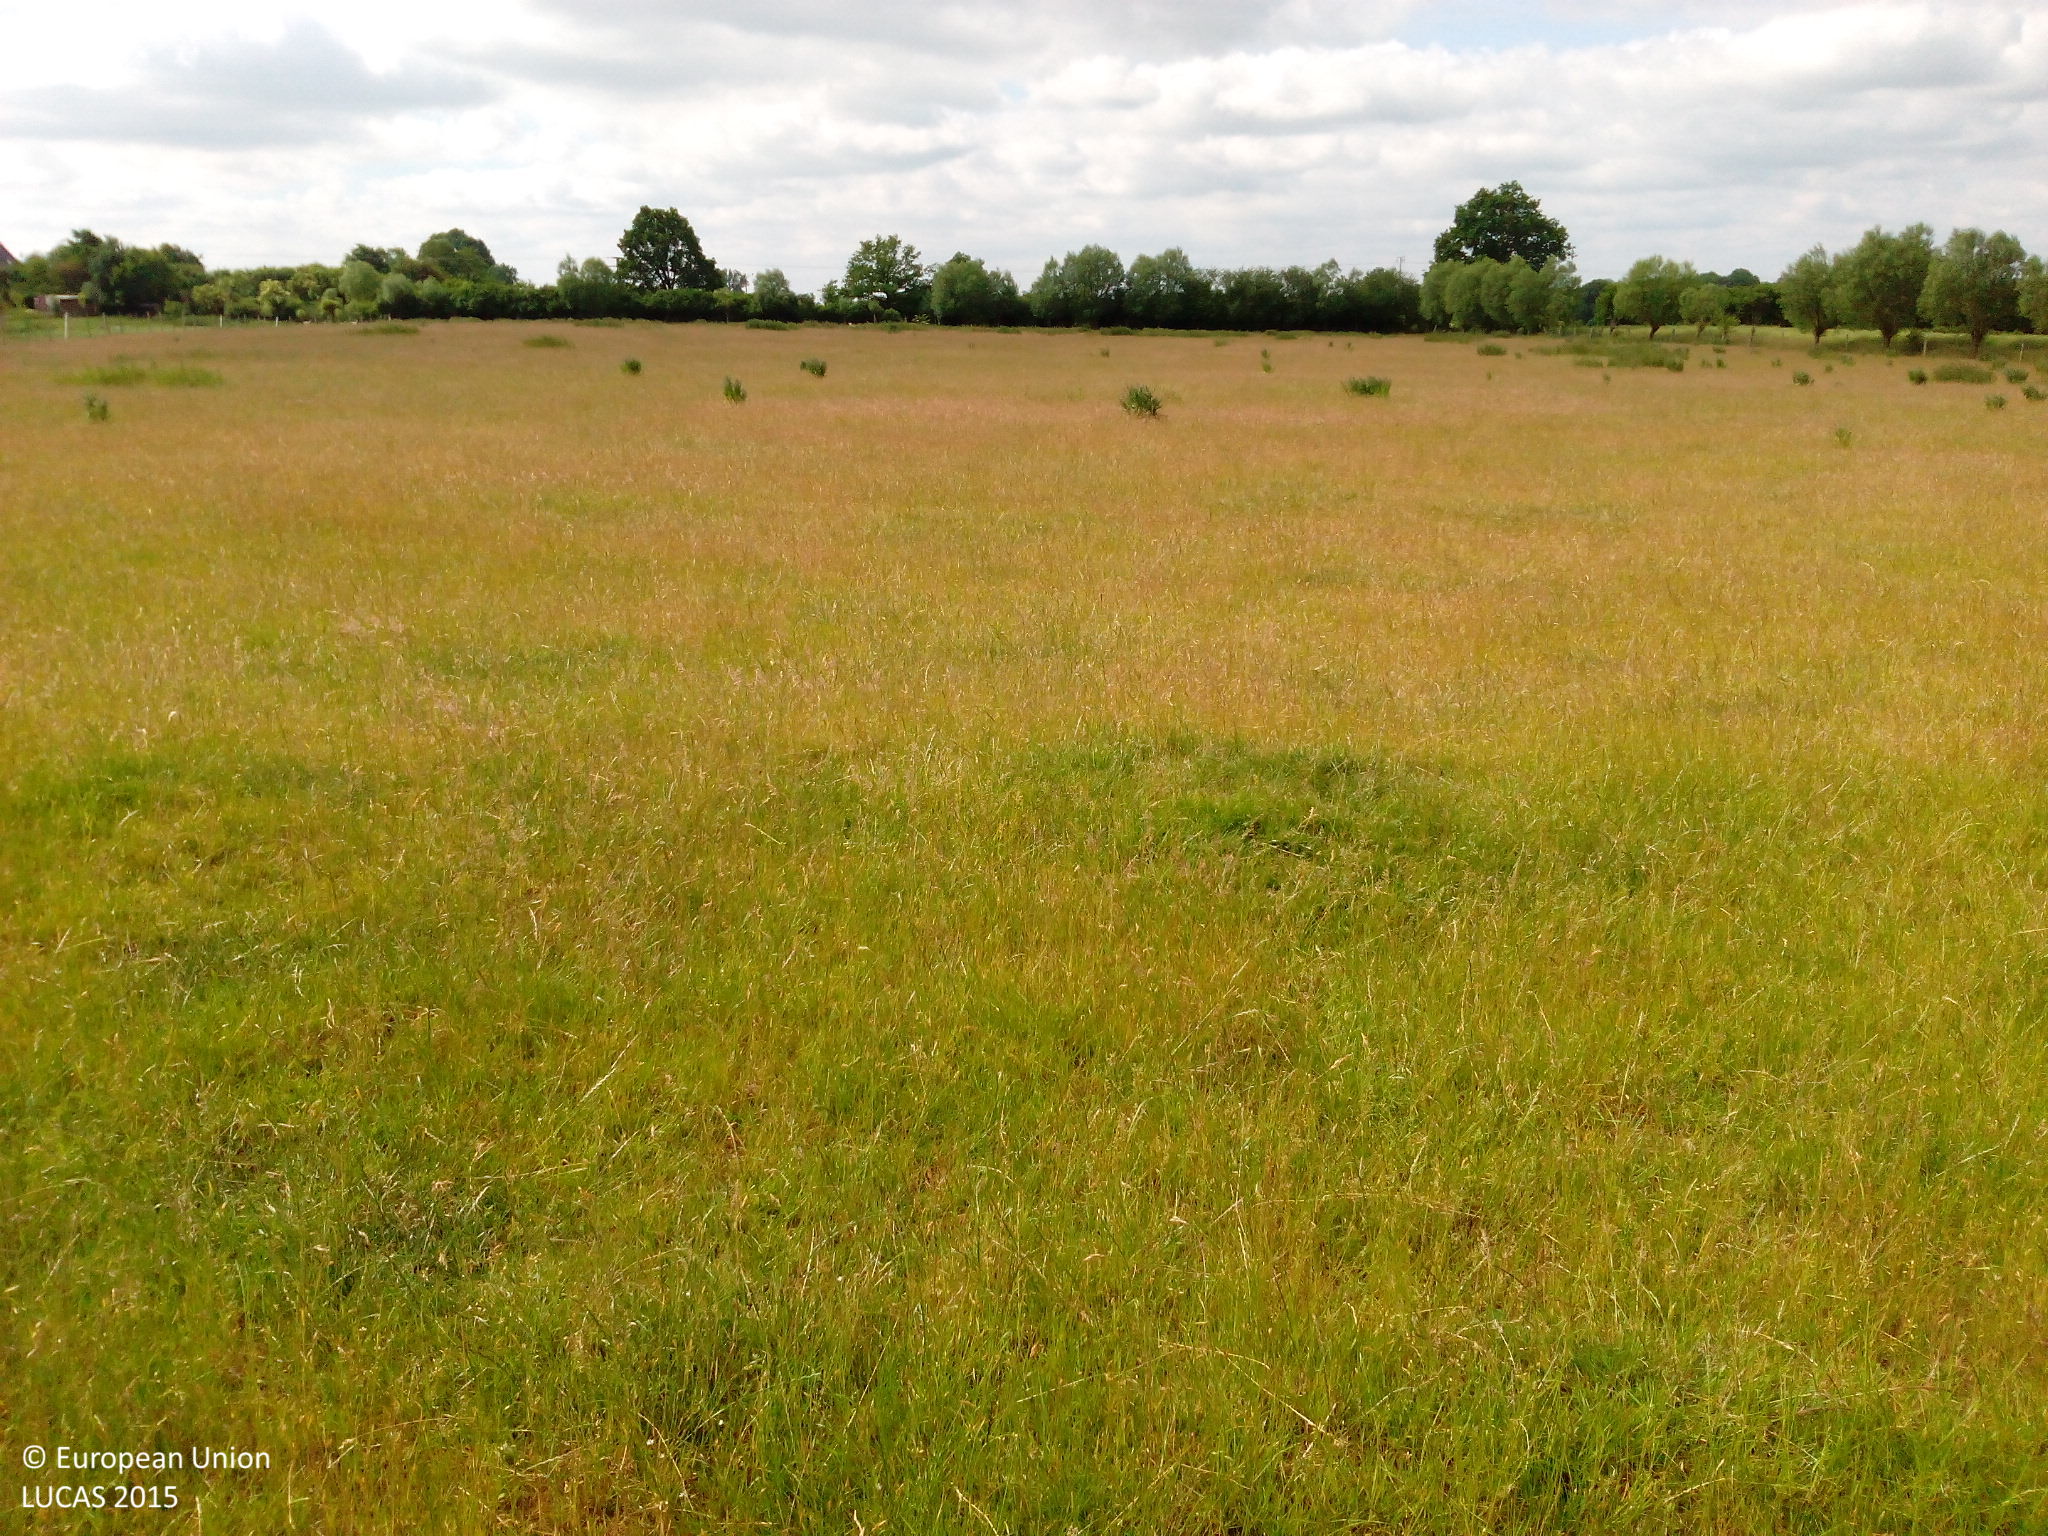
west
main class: Grassland
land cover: Grassland without tree/shrub cover
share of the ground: > 75 %
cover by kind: herbaceous plants 100 %
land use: Agriculture (excluding fallow land and kitchen gardens)
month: June
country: DE
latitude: 53.7566
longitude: 11.0763
